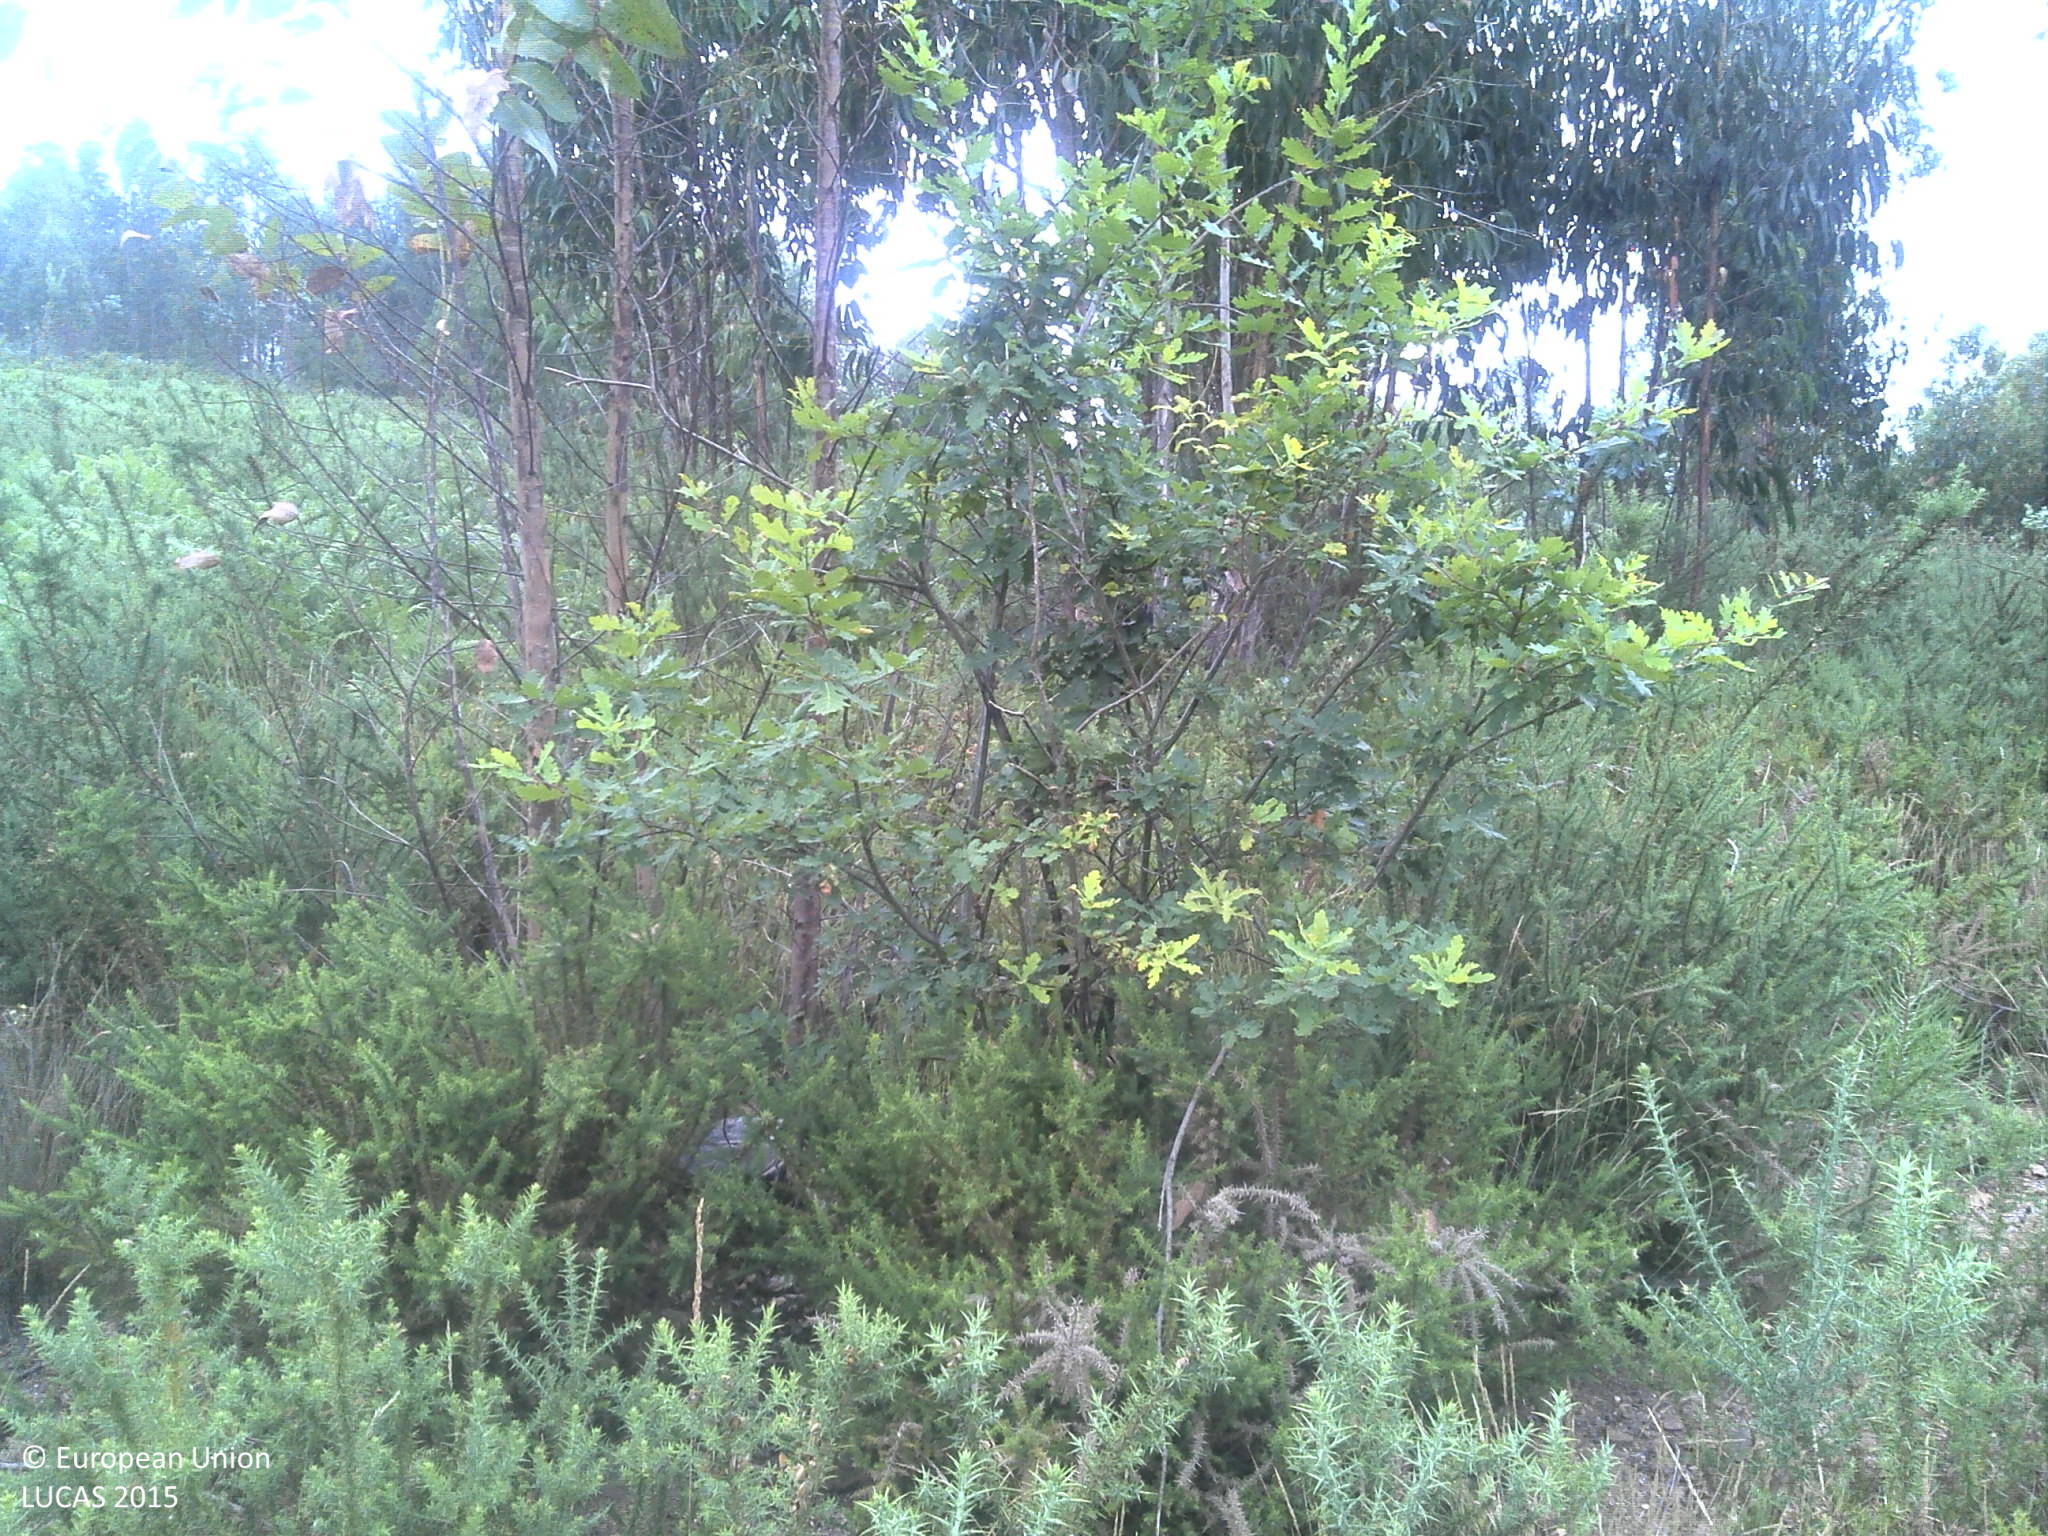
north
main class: Shrubland
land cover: Shrubland with sparse tree cover
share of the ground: 50 - 75 %
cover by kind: shrubs 75 %, herbaceous plants 15 %, broadleaved forest trees 5 %, unconsolidated bare surface 5 %
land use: Forestry
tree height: > 5 m
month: June
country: PT
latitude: 41.2521
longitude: -8.2723
